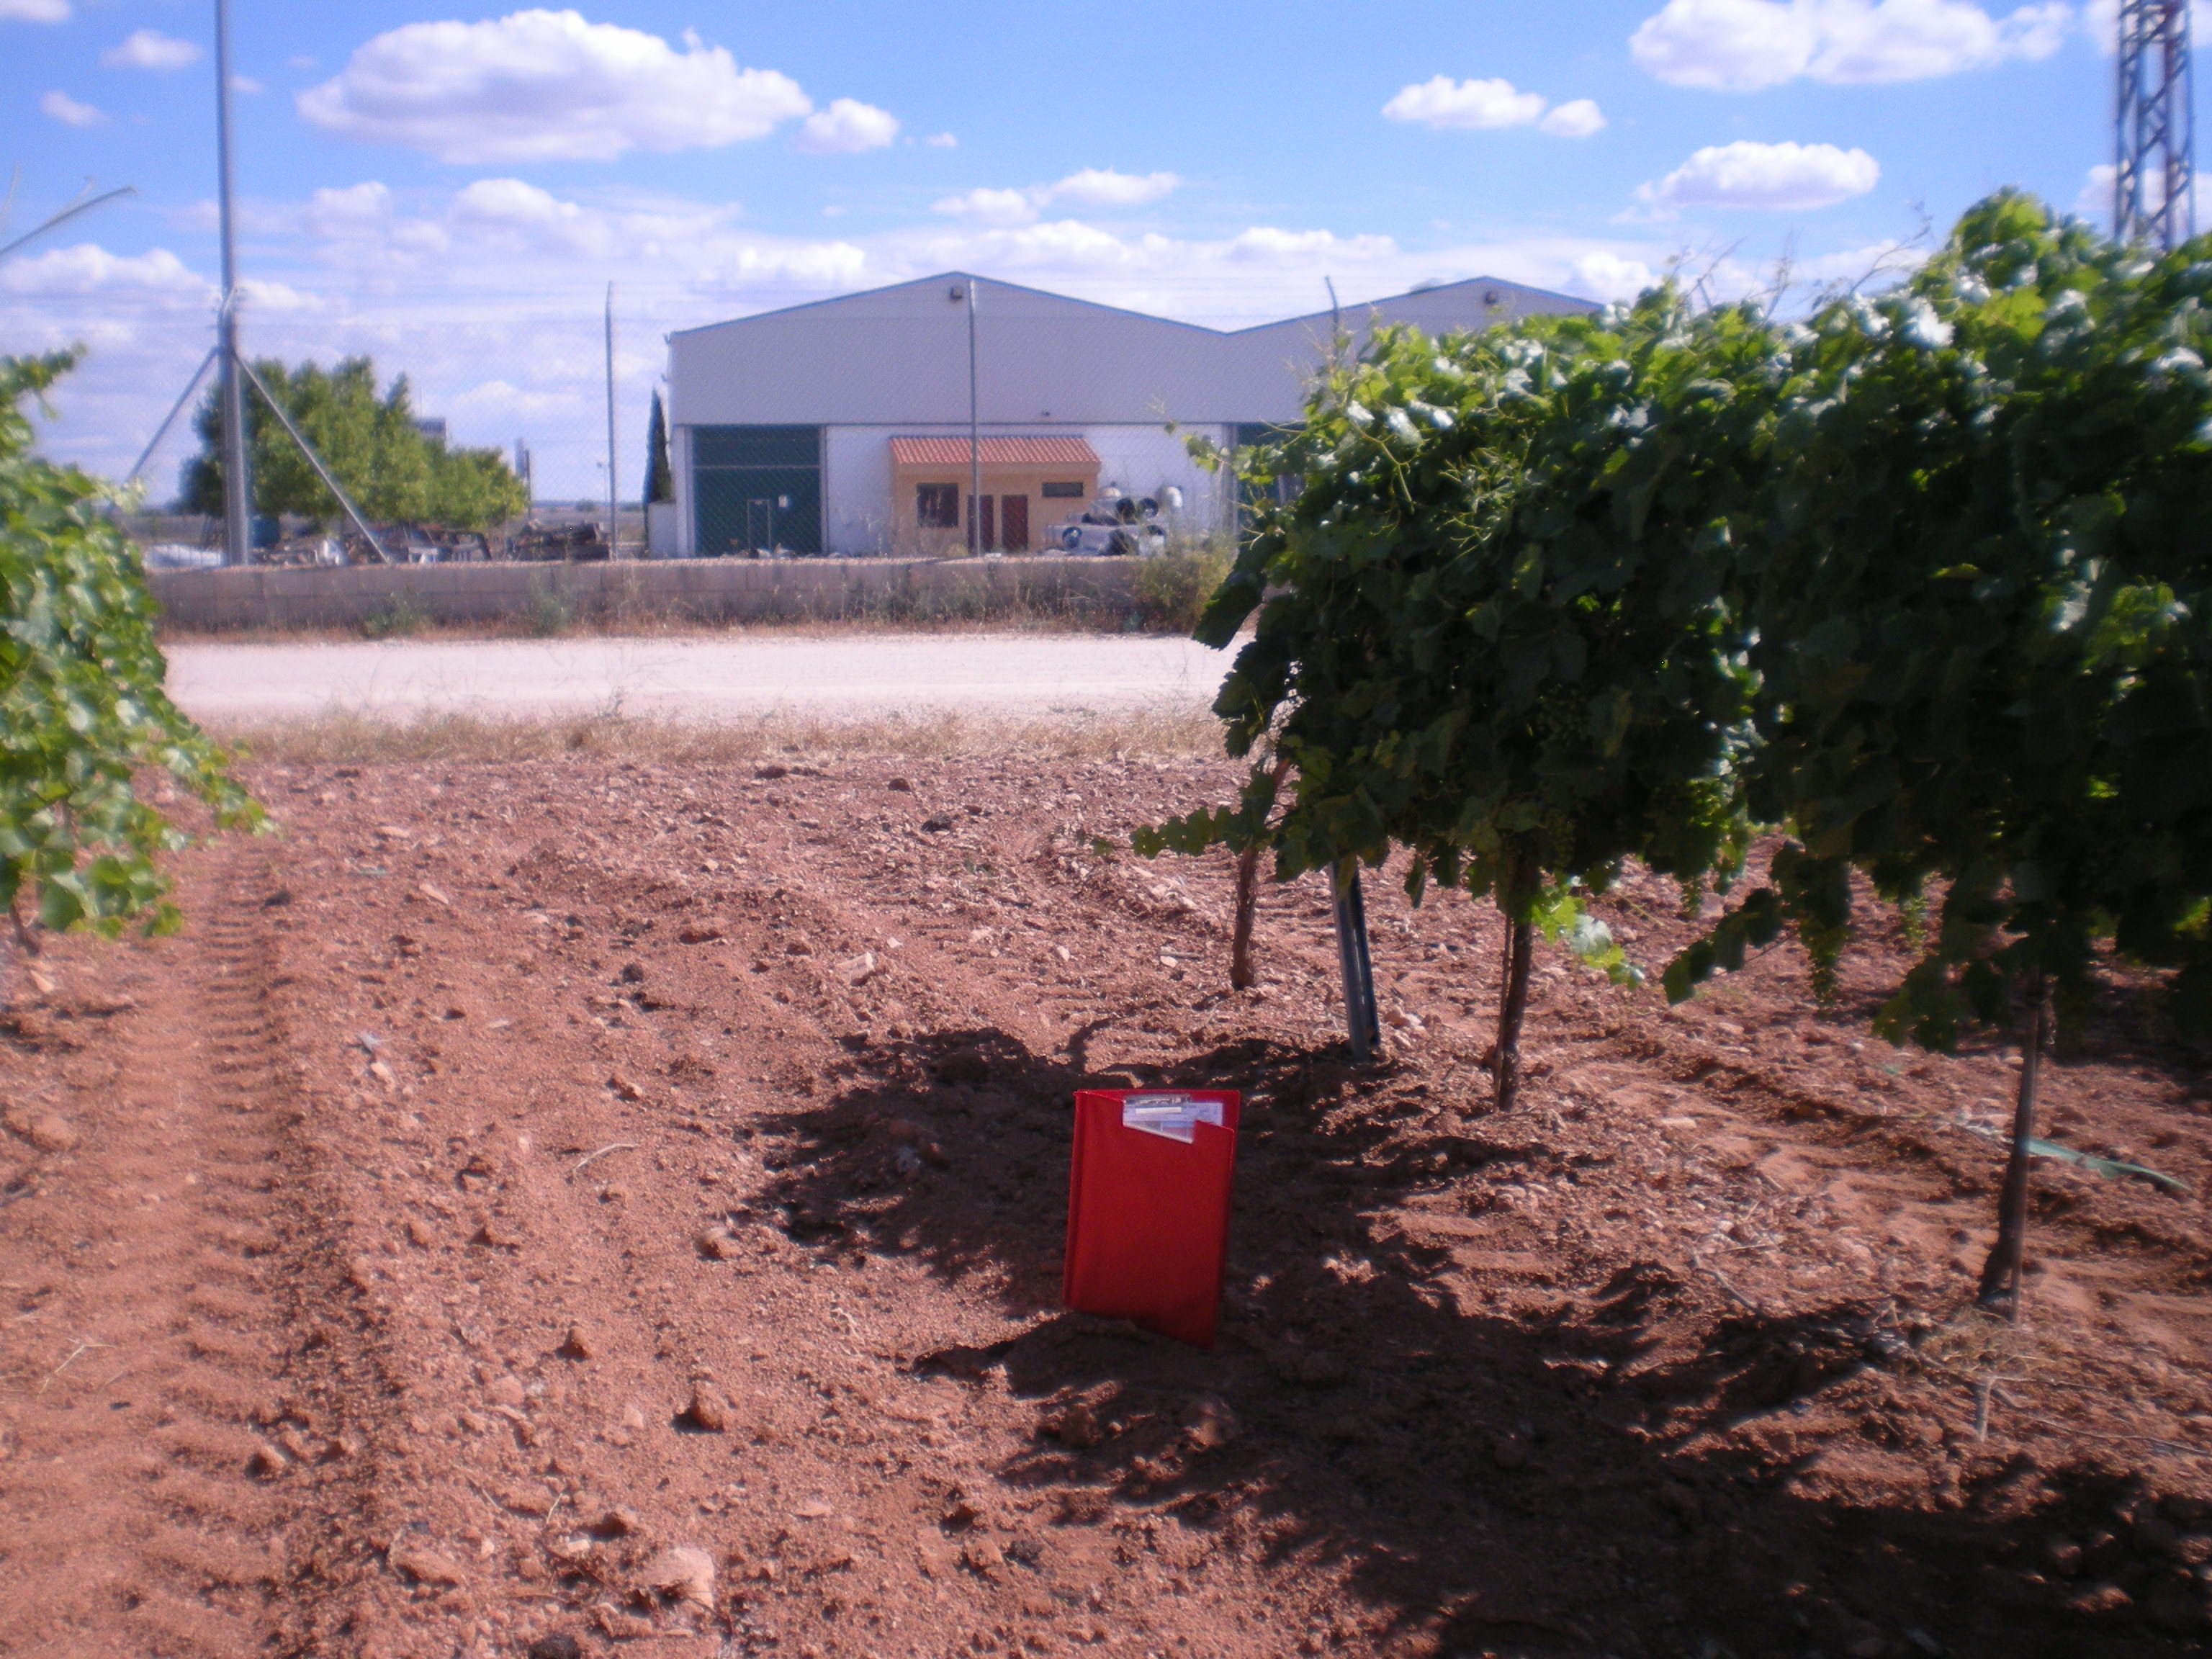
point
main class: Cropland
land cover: Vineyards
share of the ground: 10 - 25 %
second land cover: Other bare soil
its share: > 75 %
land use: Agriculture (excluding fallow land and kitchen gardens)
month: June
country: ES
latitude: 39.1623
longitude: -2.9859
